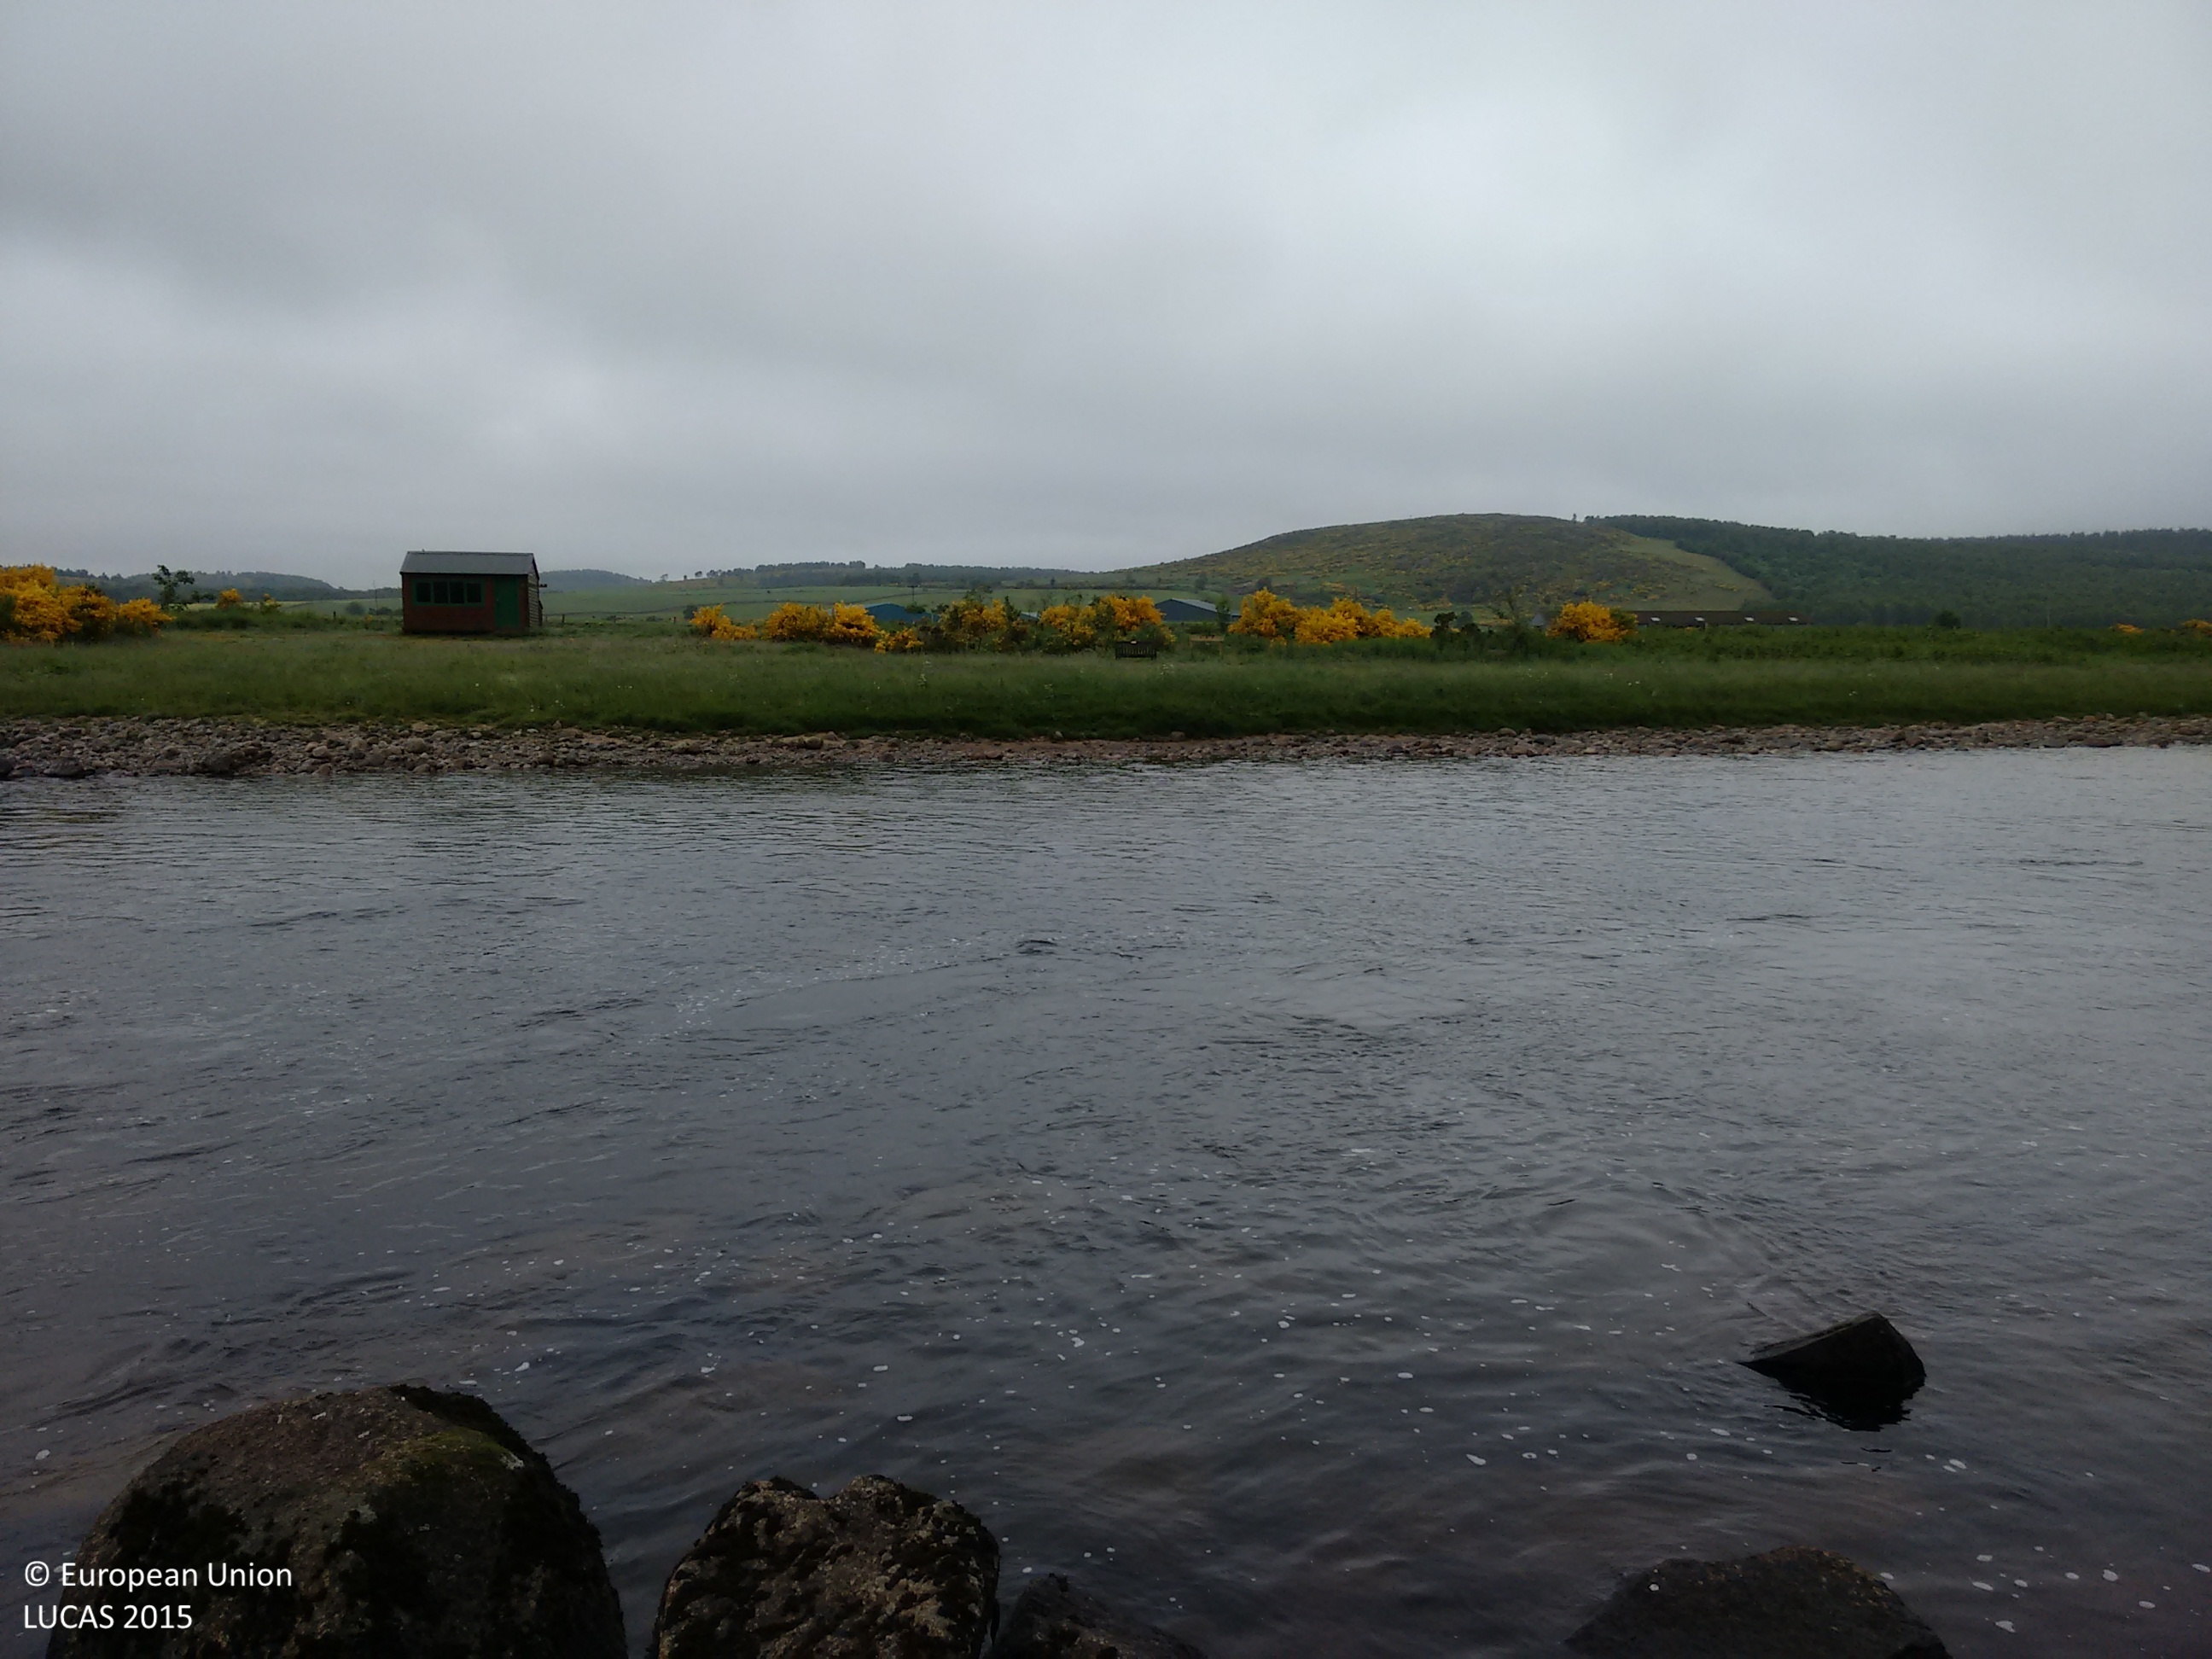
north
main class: Shrubland
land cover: Shrubland without tree cover
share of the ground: > 75 %
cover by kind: shrubs 50 %, herbaceous plants 50 %
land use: Semi-natural and natural areas not in use
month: June
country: GB
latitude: 57.0708
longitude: -2.8434
